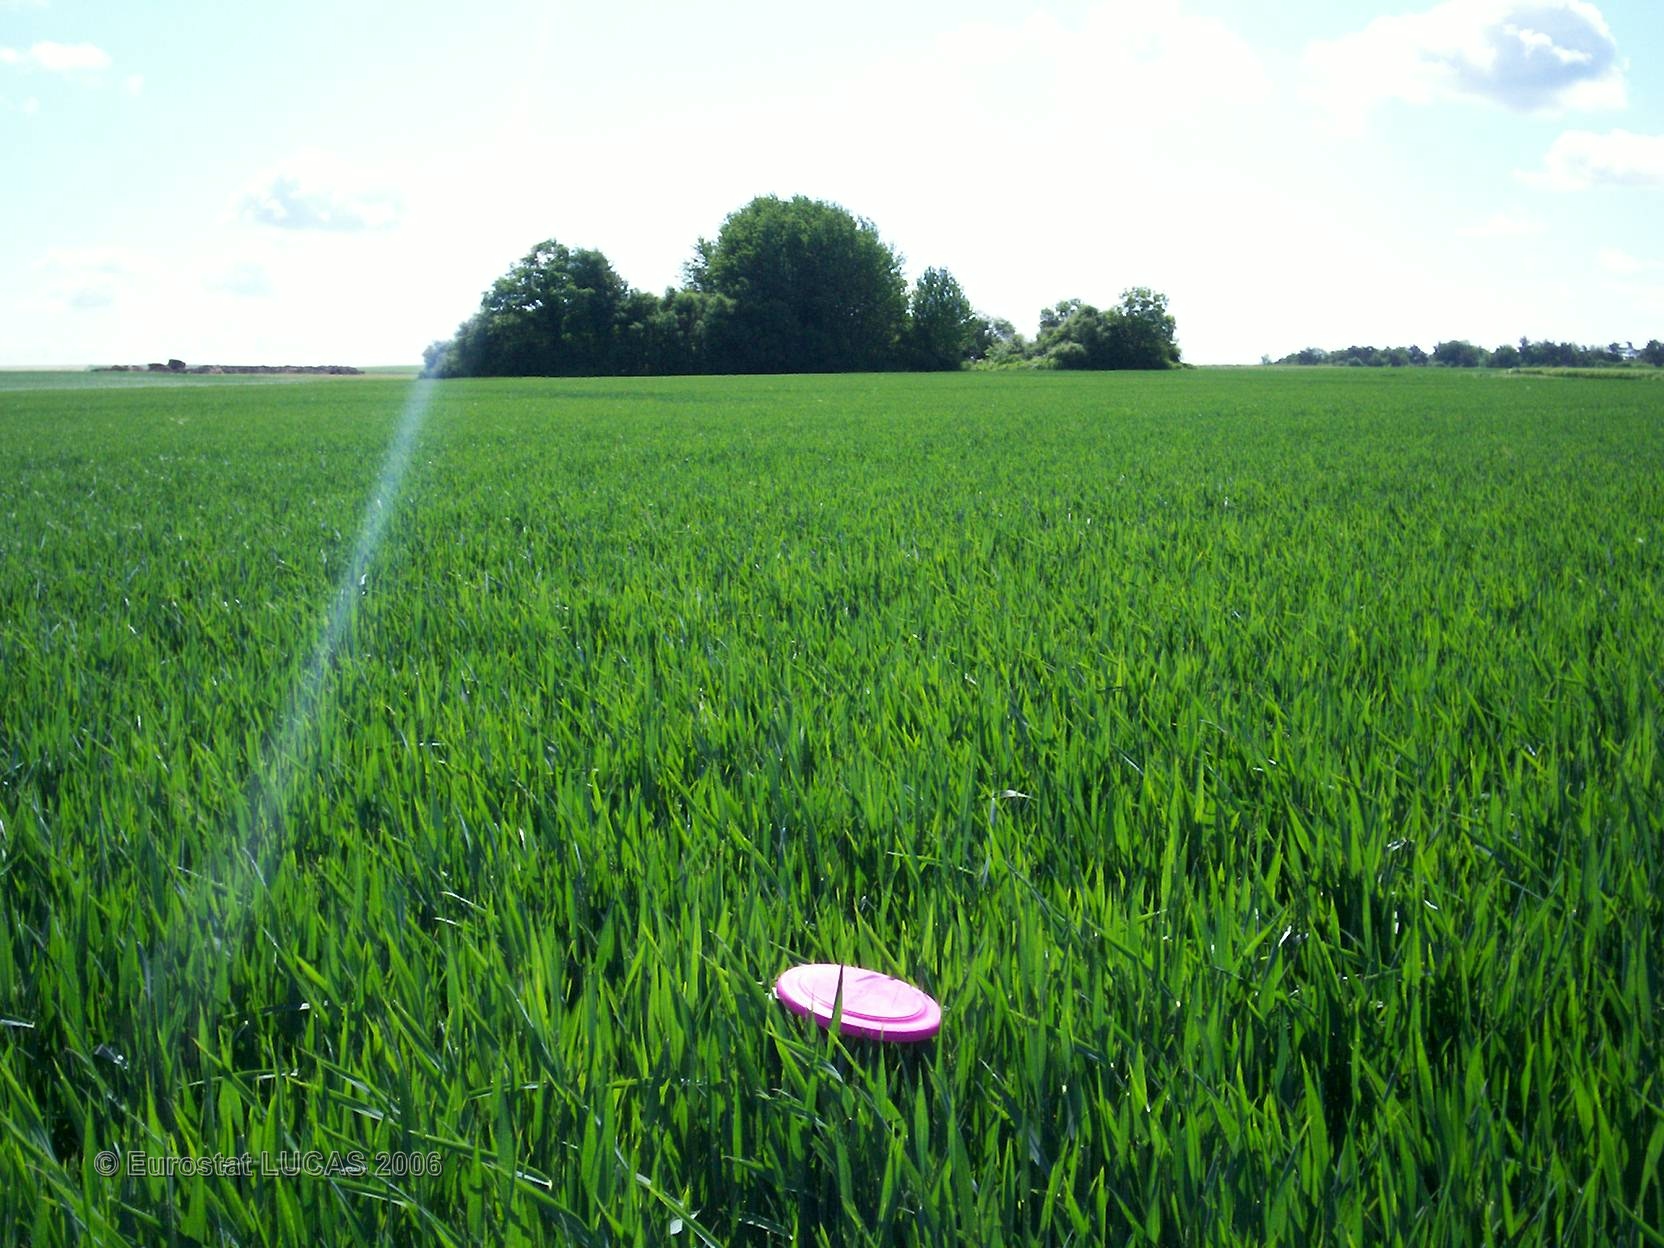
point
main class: Cropland
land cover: Common wheat
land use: Agriculture (excluding fallow land and kitchen gardens)
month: May
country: FR
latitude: 48.1584
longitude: 4.4993
